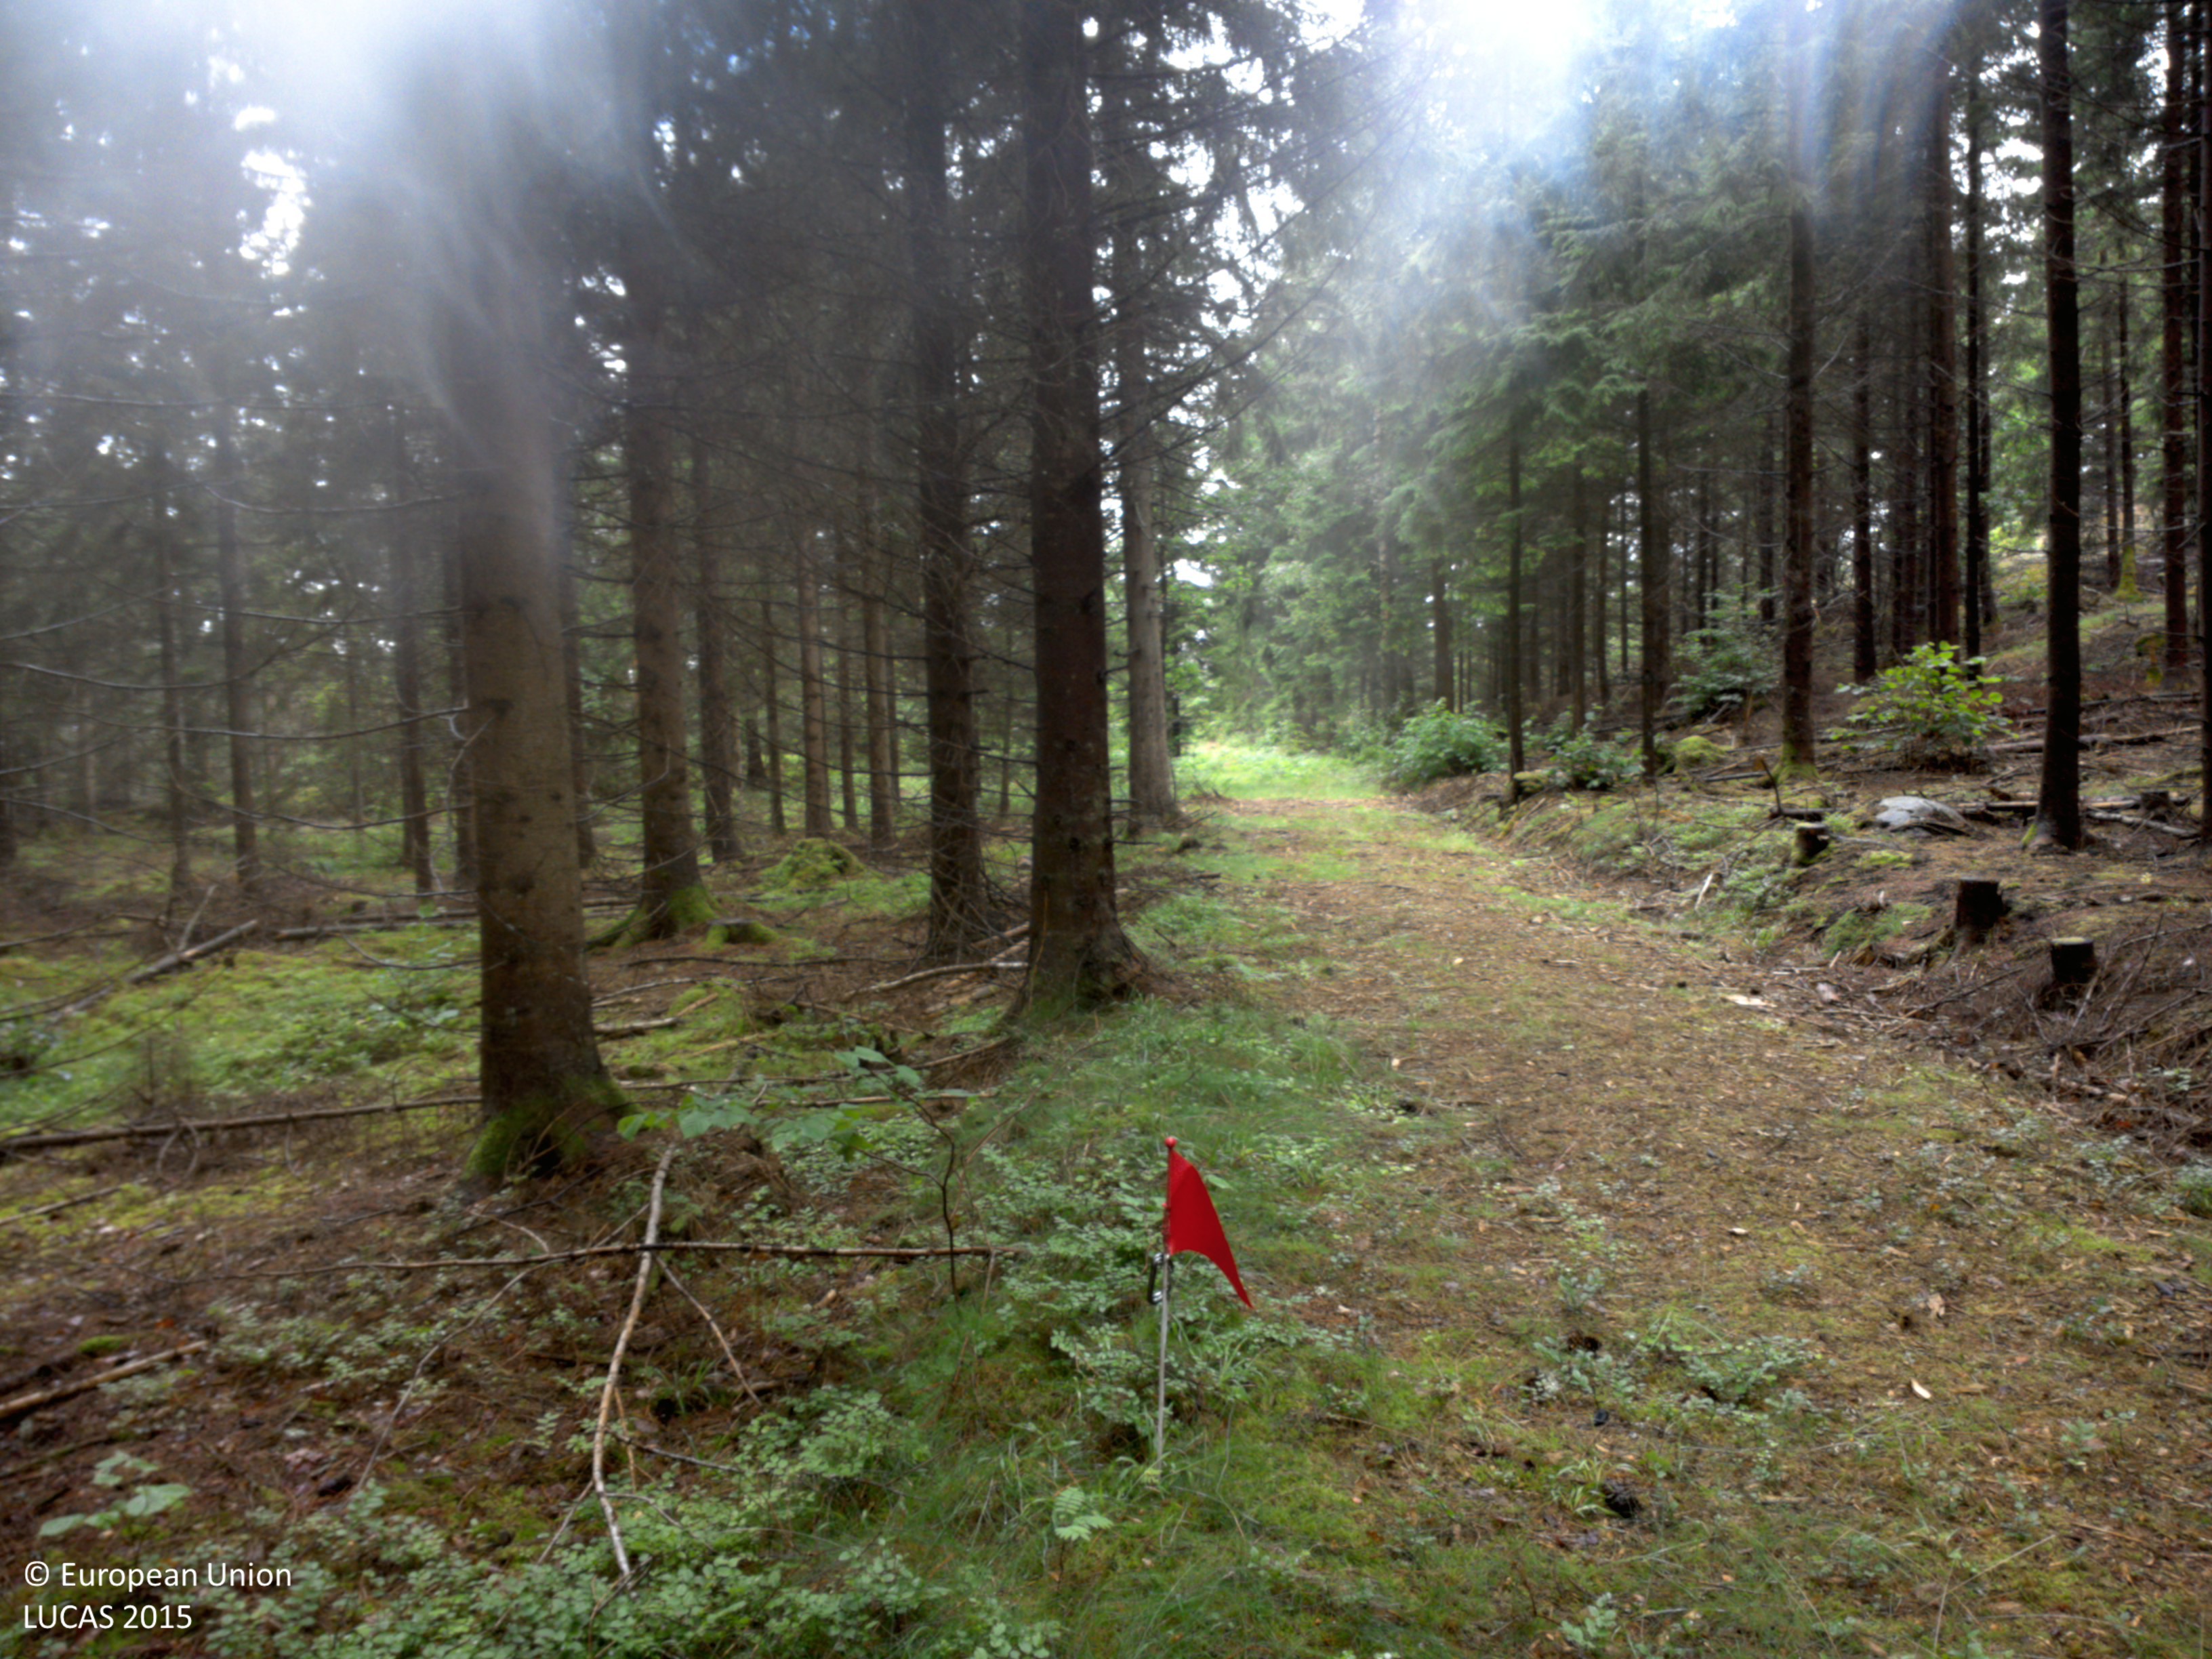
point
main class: Woodland
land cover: Spruce dominated coniferous woodland
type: boreal forest
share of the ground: 50 - 75 %
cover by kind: coniferous forest trees 60 %, herbaceous plants 20 %, lichens and mosses 20 %
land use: Forestry
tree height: > 5 m
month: July
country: SE
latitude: 58.2587
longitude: 11.9901
